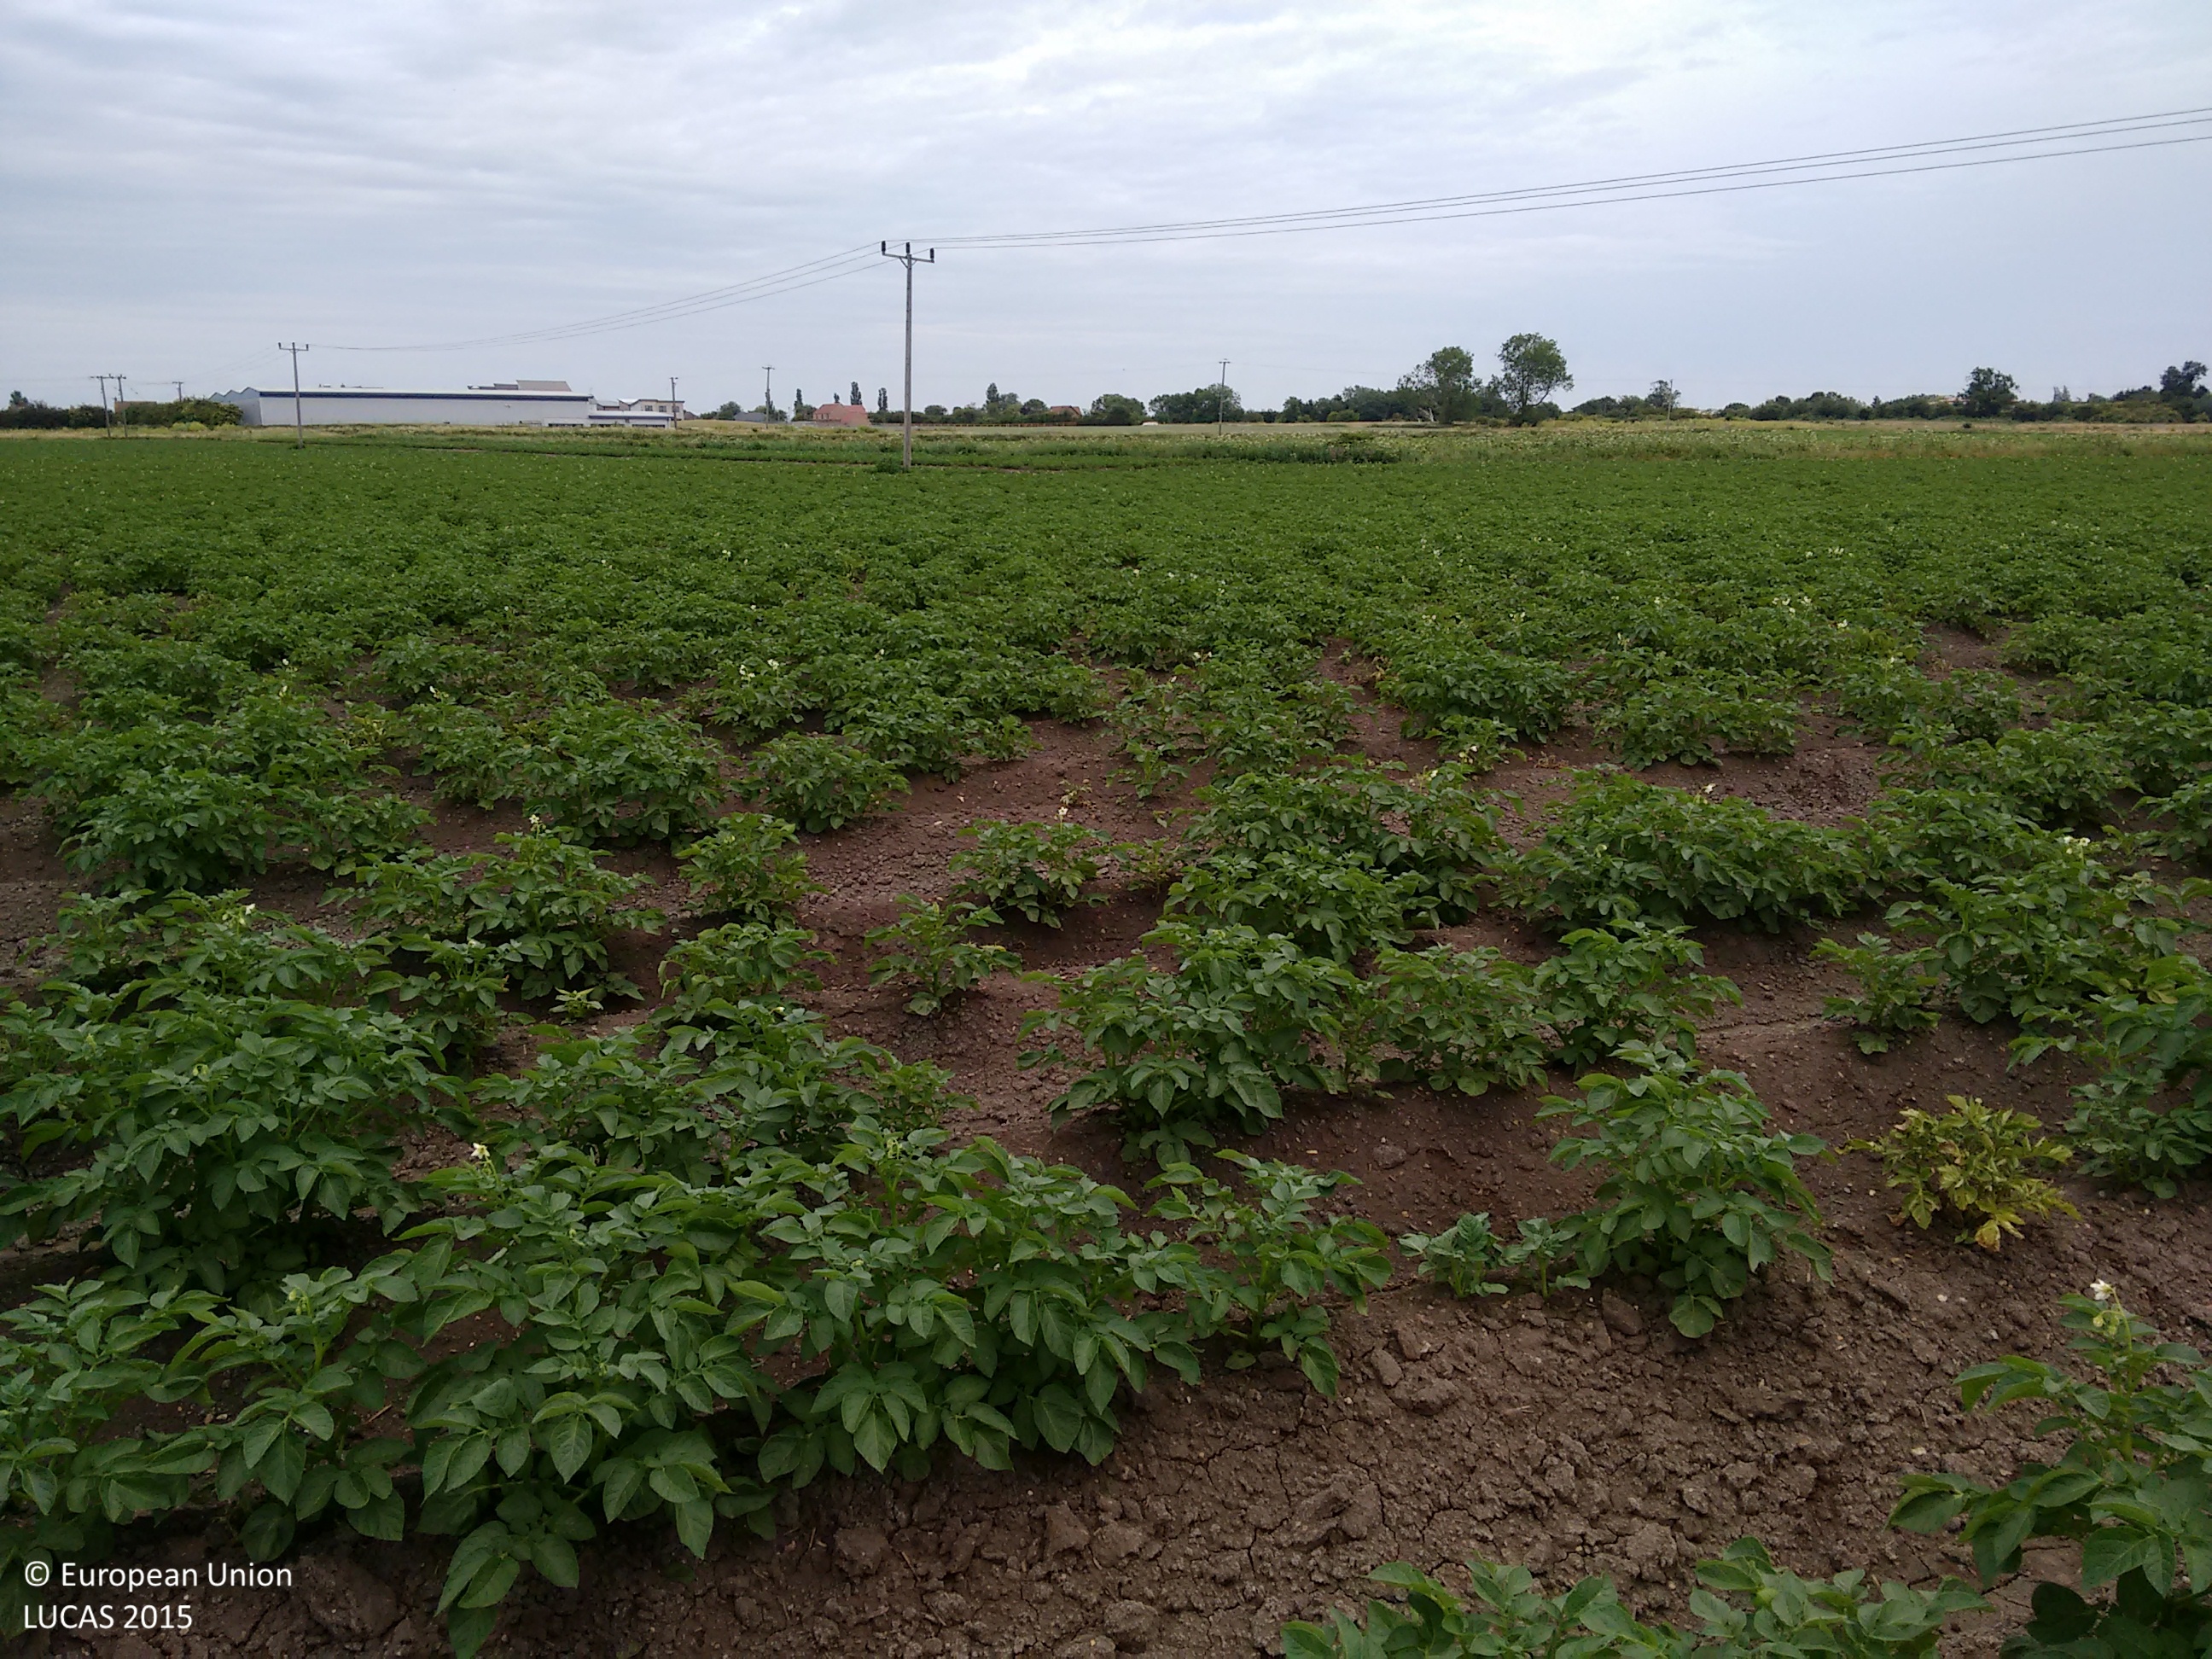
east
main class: Cropland
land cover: Potatoes
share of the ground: > 75 %
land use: Agriculture (excluding fallow land and kitchen gardens)
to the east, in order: Potatoes; Electric lines; Potatoes; Grass margins; Ditches and canals; Grass margins; Sugar beet
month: July
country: GB
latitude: 52.4643
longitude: 0.0326
